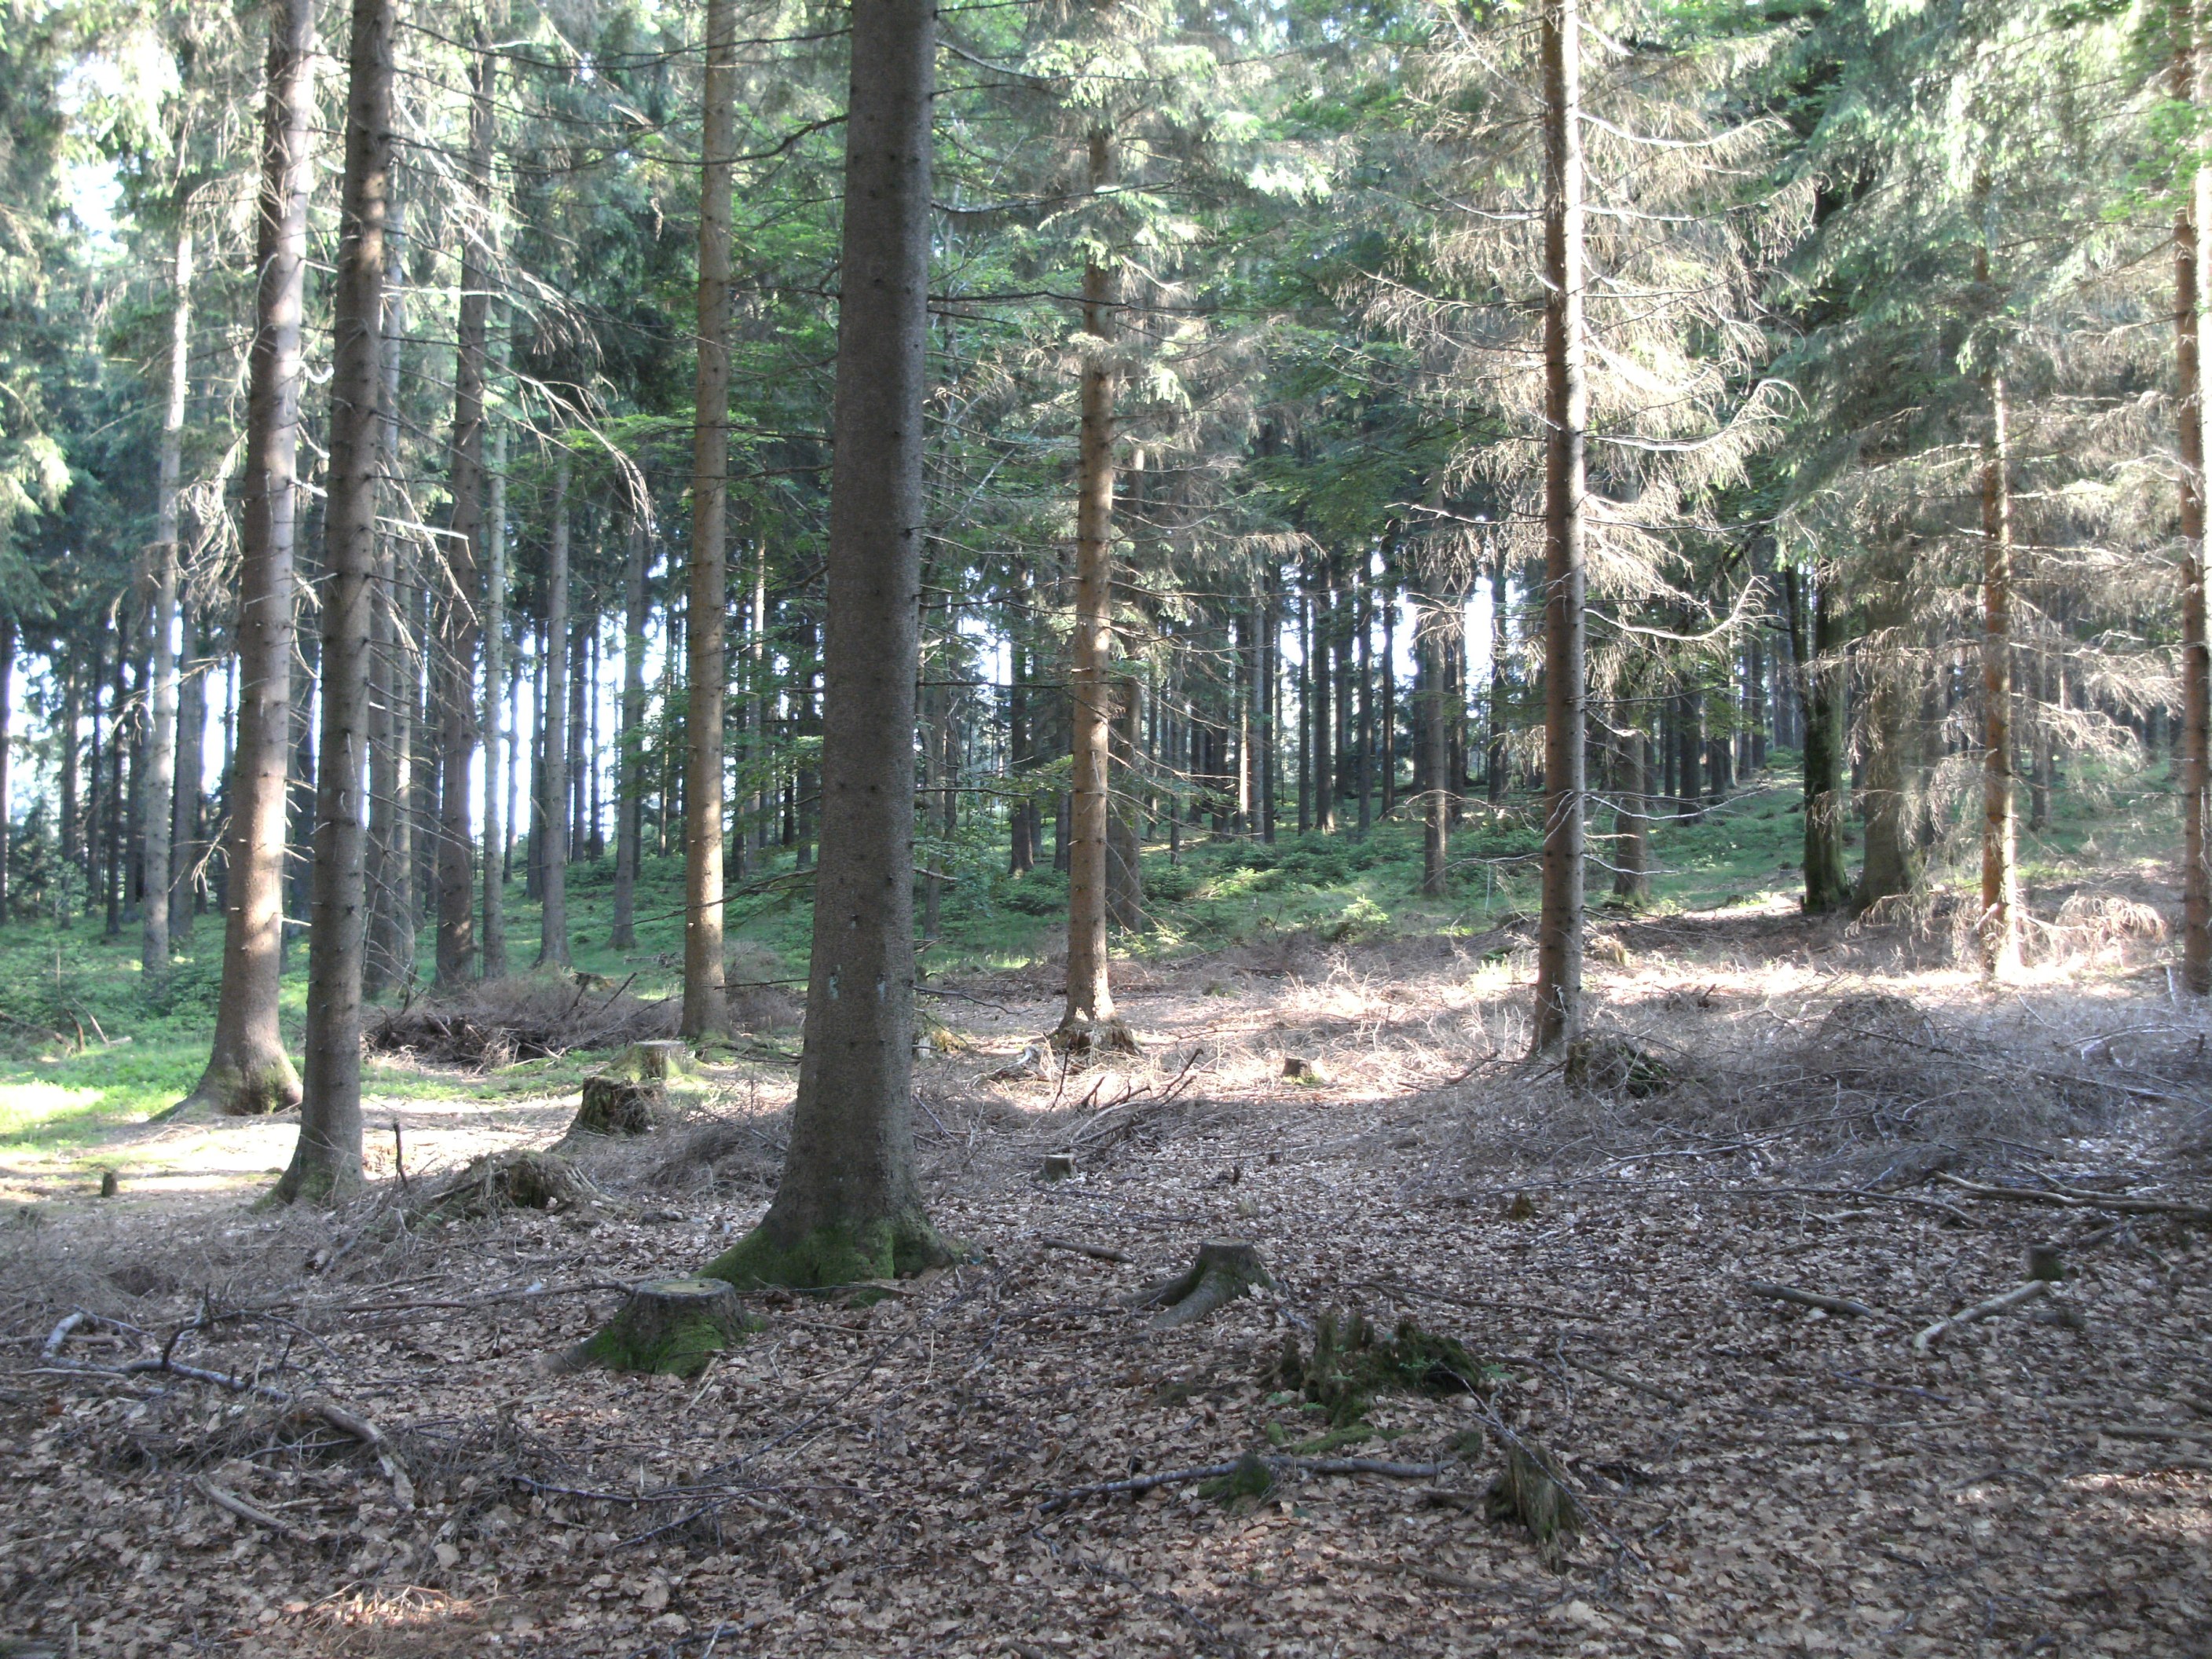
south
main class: Woodland
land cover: Spruce dominated mixed woodland
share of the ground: > 75 %
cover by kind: broadleaved forest trees 70 %, coniferous forest trees 25 %, consolidated bare surface 5 %
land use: Forestry
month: June
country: AT
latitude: 48.4856
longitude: 14.2080
